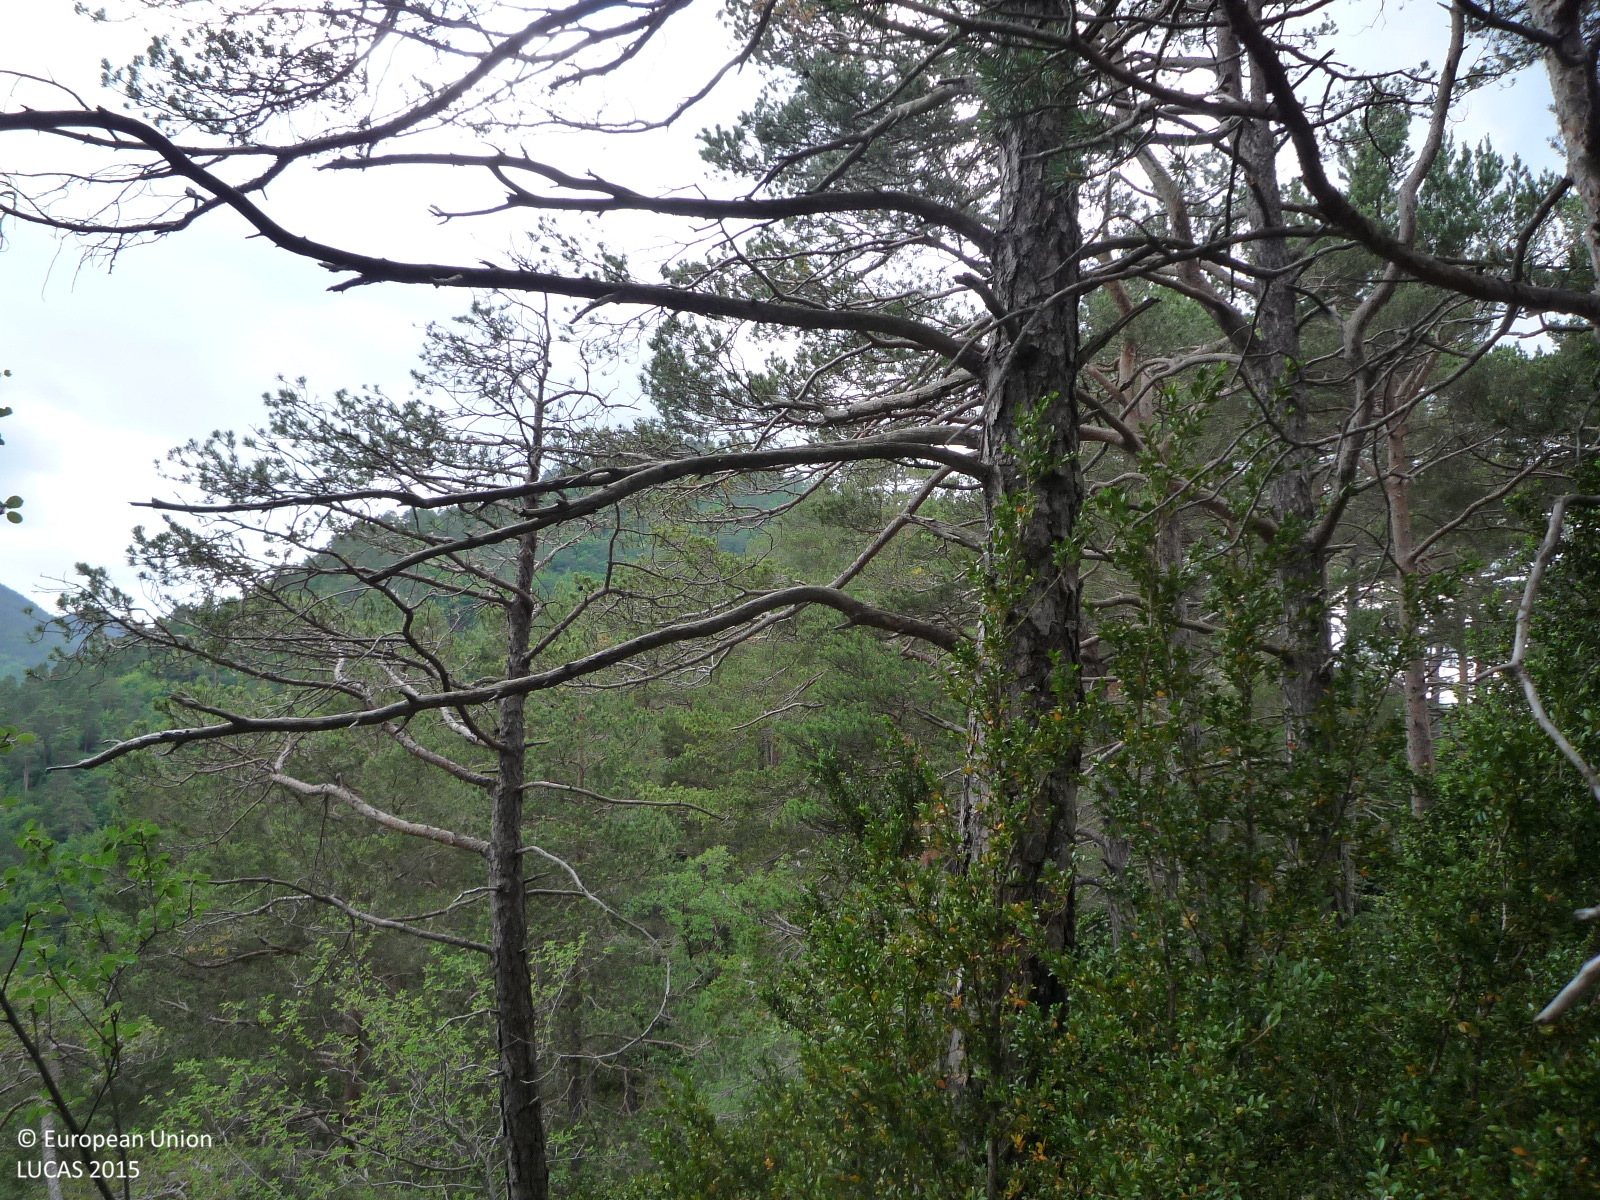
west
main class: Woodland
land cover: Pine dominated mixed woodland
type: alpine coniferous forest
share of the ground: > 75 %
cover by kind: coniferous forest trees 60 %, broadleaved forest trees 20 %, consolidated bare surface 20 %
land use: Forestry
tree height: > 5 m
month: June
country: ES
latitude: 42.2248
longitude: 1.9556
